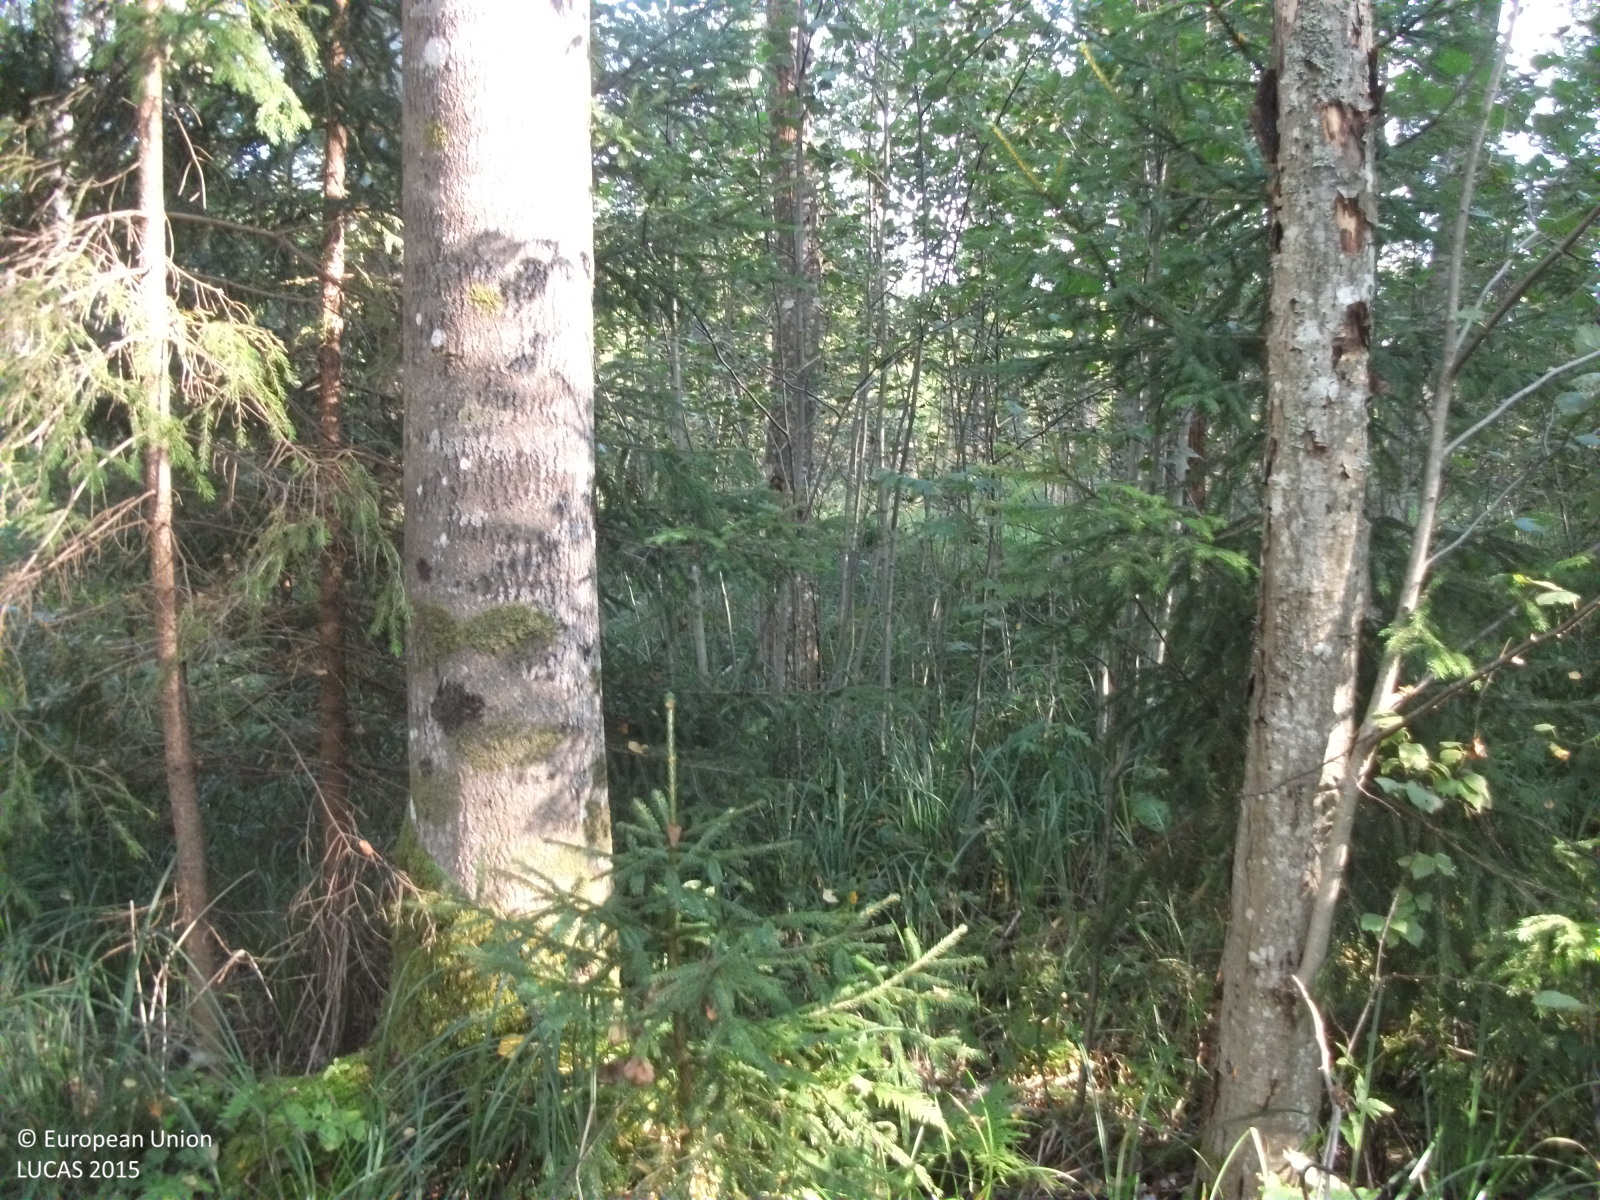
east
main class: Woodland
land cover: Spruce dominated mixed woodland
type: hemiboreal forest and nemoral coniferous forest and mixed broadleaved-coniferous forest
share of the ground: > 75 %
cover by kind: broadleaved forest trees 55 %, coniferous forest trees 30 %, herbaceous plants 10 %, shrubs 5 %
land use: Forestry
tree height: > 5 m
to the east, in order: Spruce dominated mixed woodland; Spruce dominated coniferous woodland; Ditches and canals; Spontaneously vegetated surfaces; Spruce dominated coniferous woodland; Broadleaved woodland; Spruce dominated mixed woodland; Abandoned hedges; Electric lines; Abandoned hedges; Grass margins
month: September
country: LV
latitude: 58.0116
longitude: 25.0106
